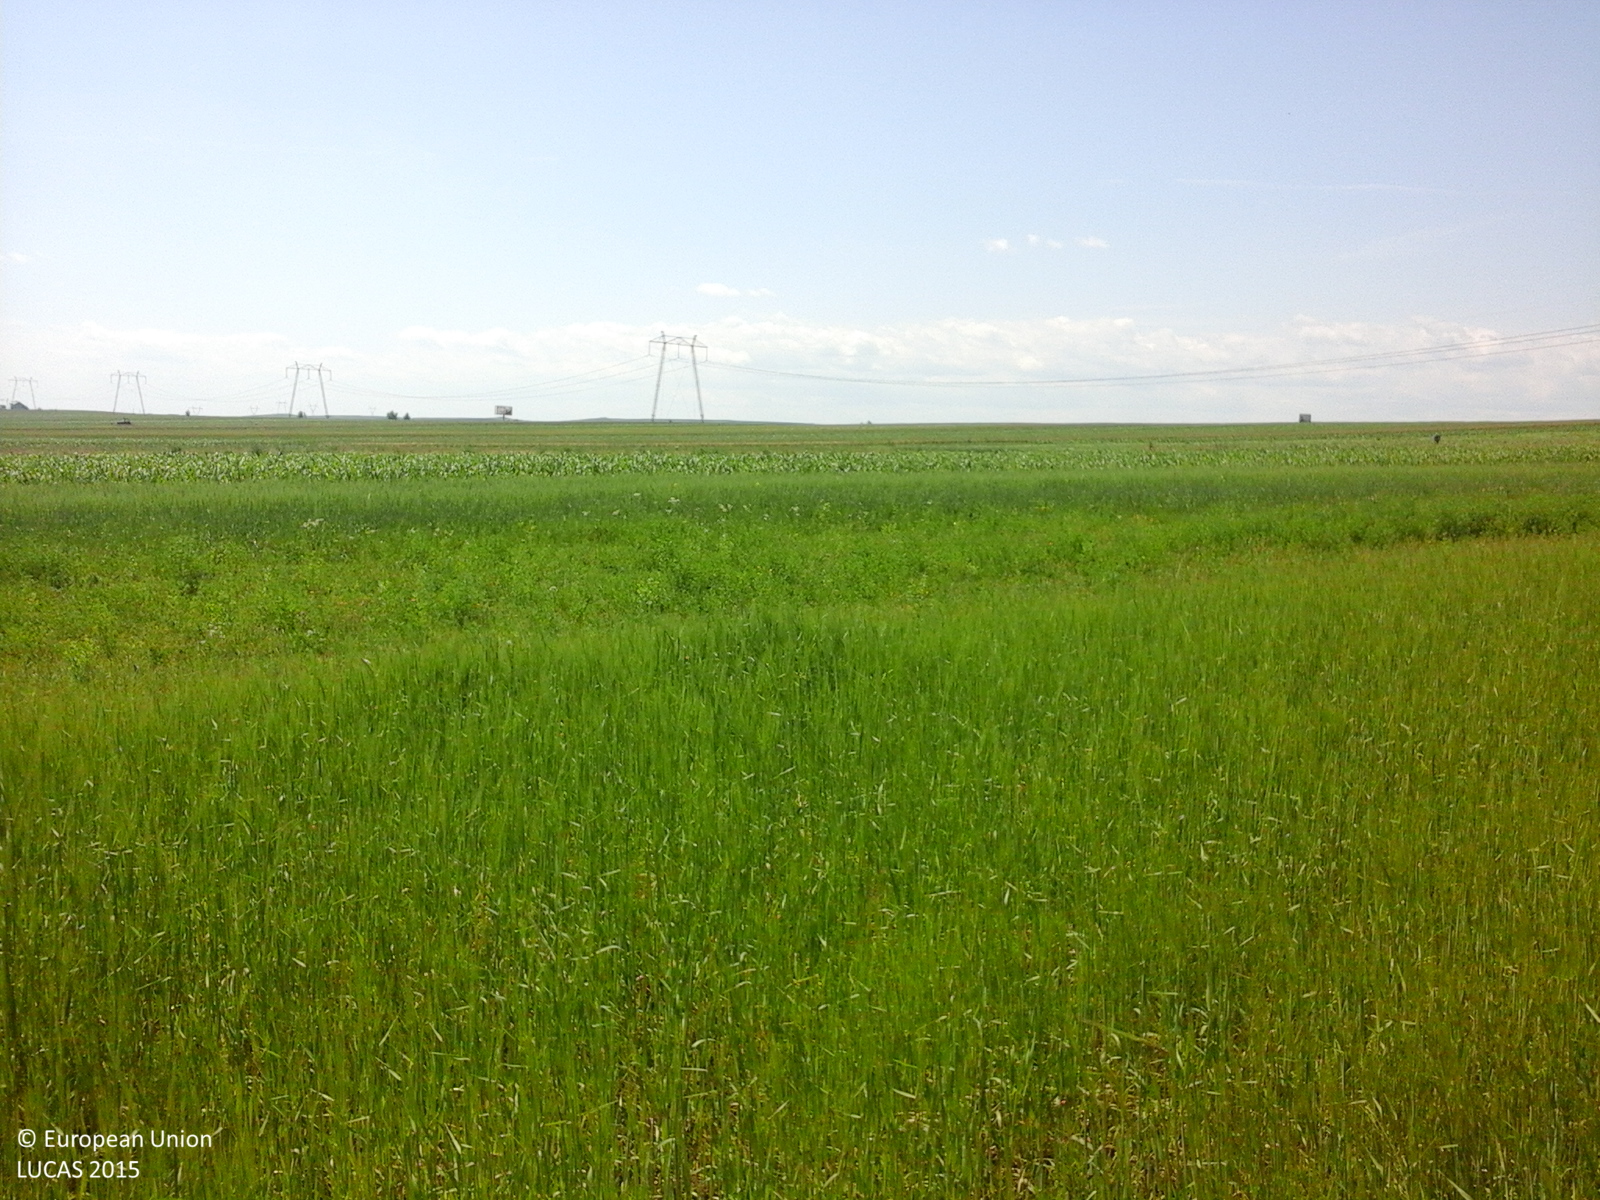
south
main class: Cropland
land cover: Barley
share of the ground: > 75 %
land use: Agriculture (excluding fallow land and kitchen gardens)
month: June
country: RO
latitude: 47.5918
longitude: 26.2672
